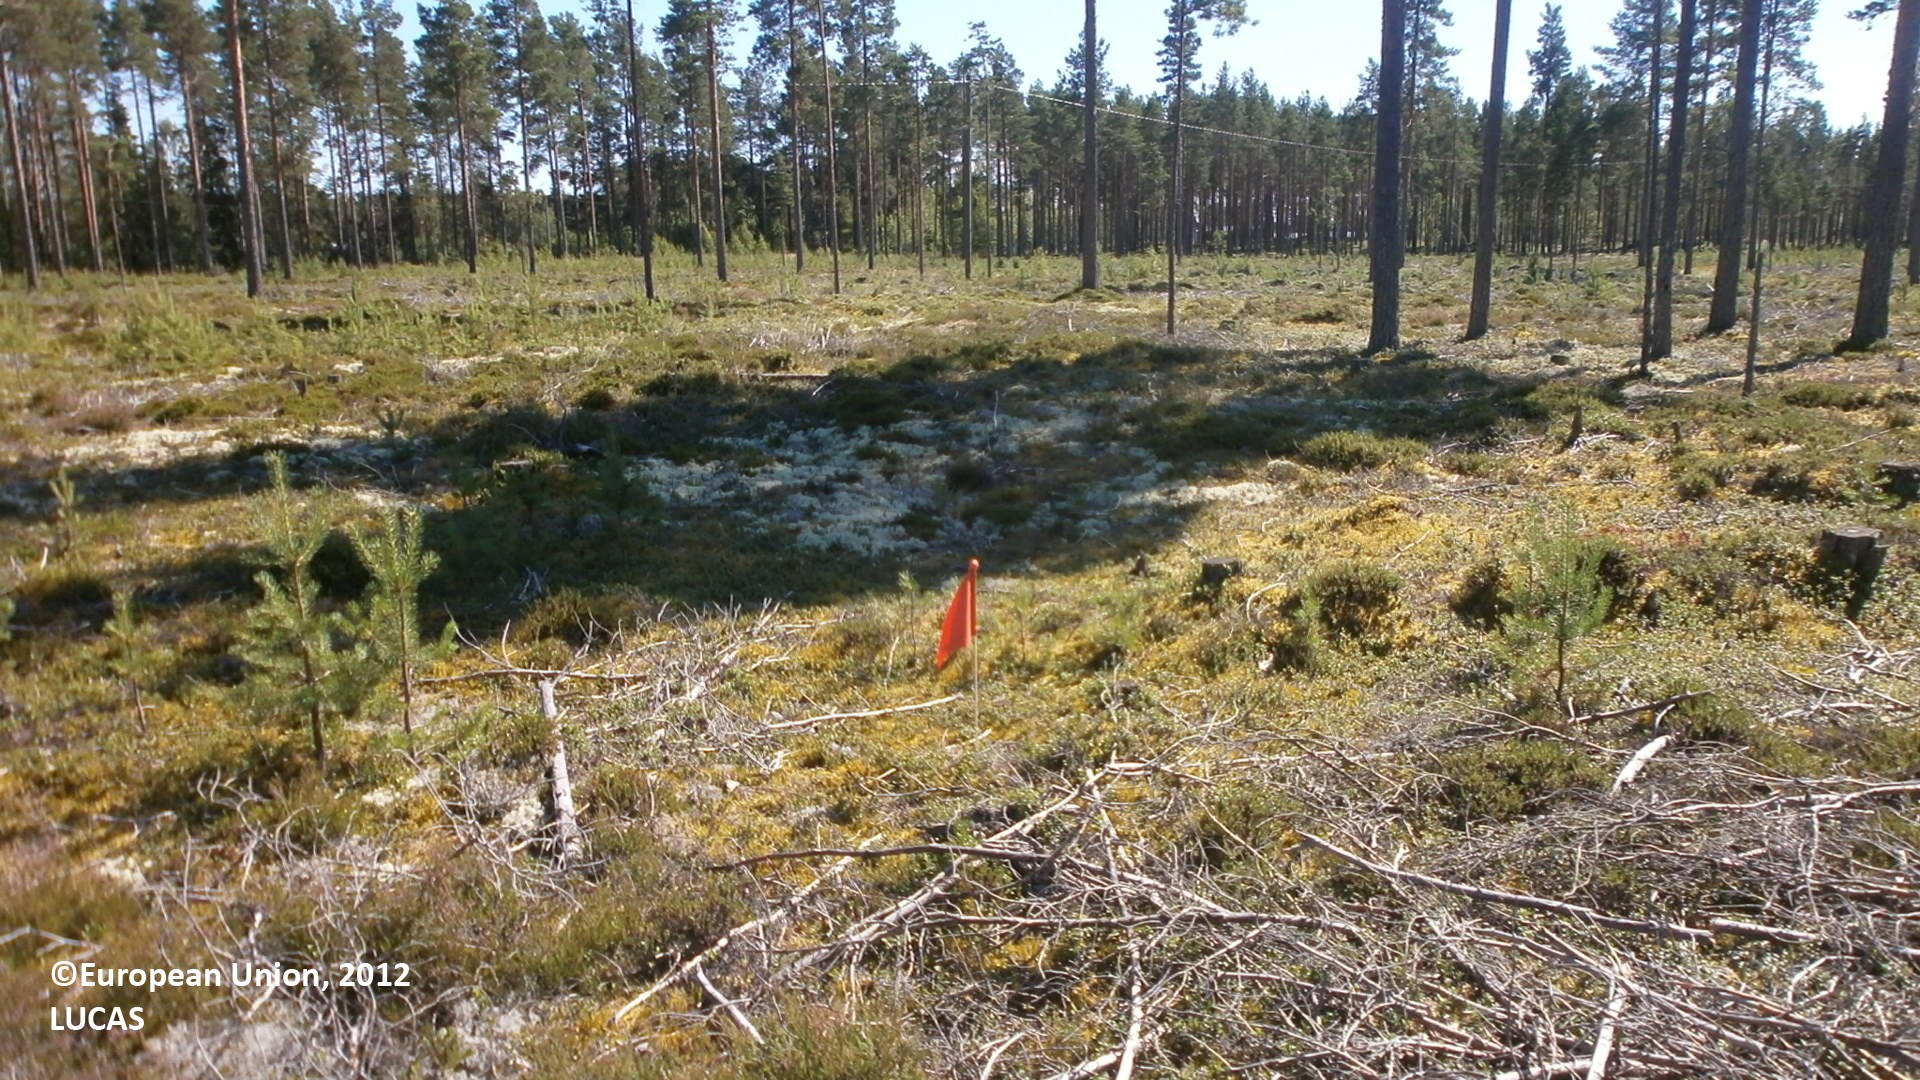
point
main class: Woodland
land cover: Pine dominated coniferous woodland
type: boreal forest
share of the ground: 10 - 25 %
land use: Forestry
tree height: > 5 m
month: July
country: FI
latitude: 64.1579
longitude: 23.8165
